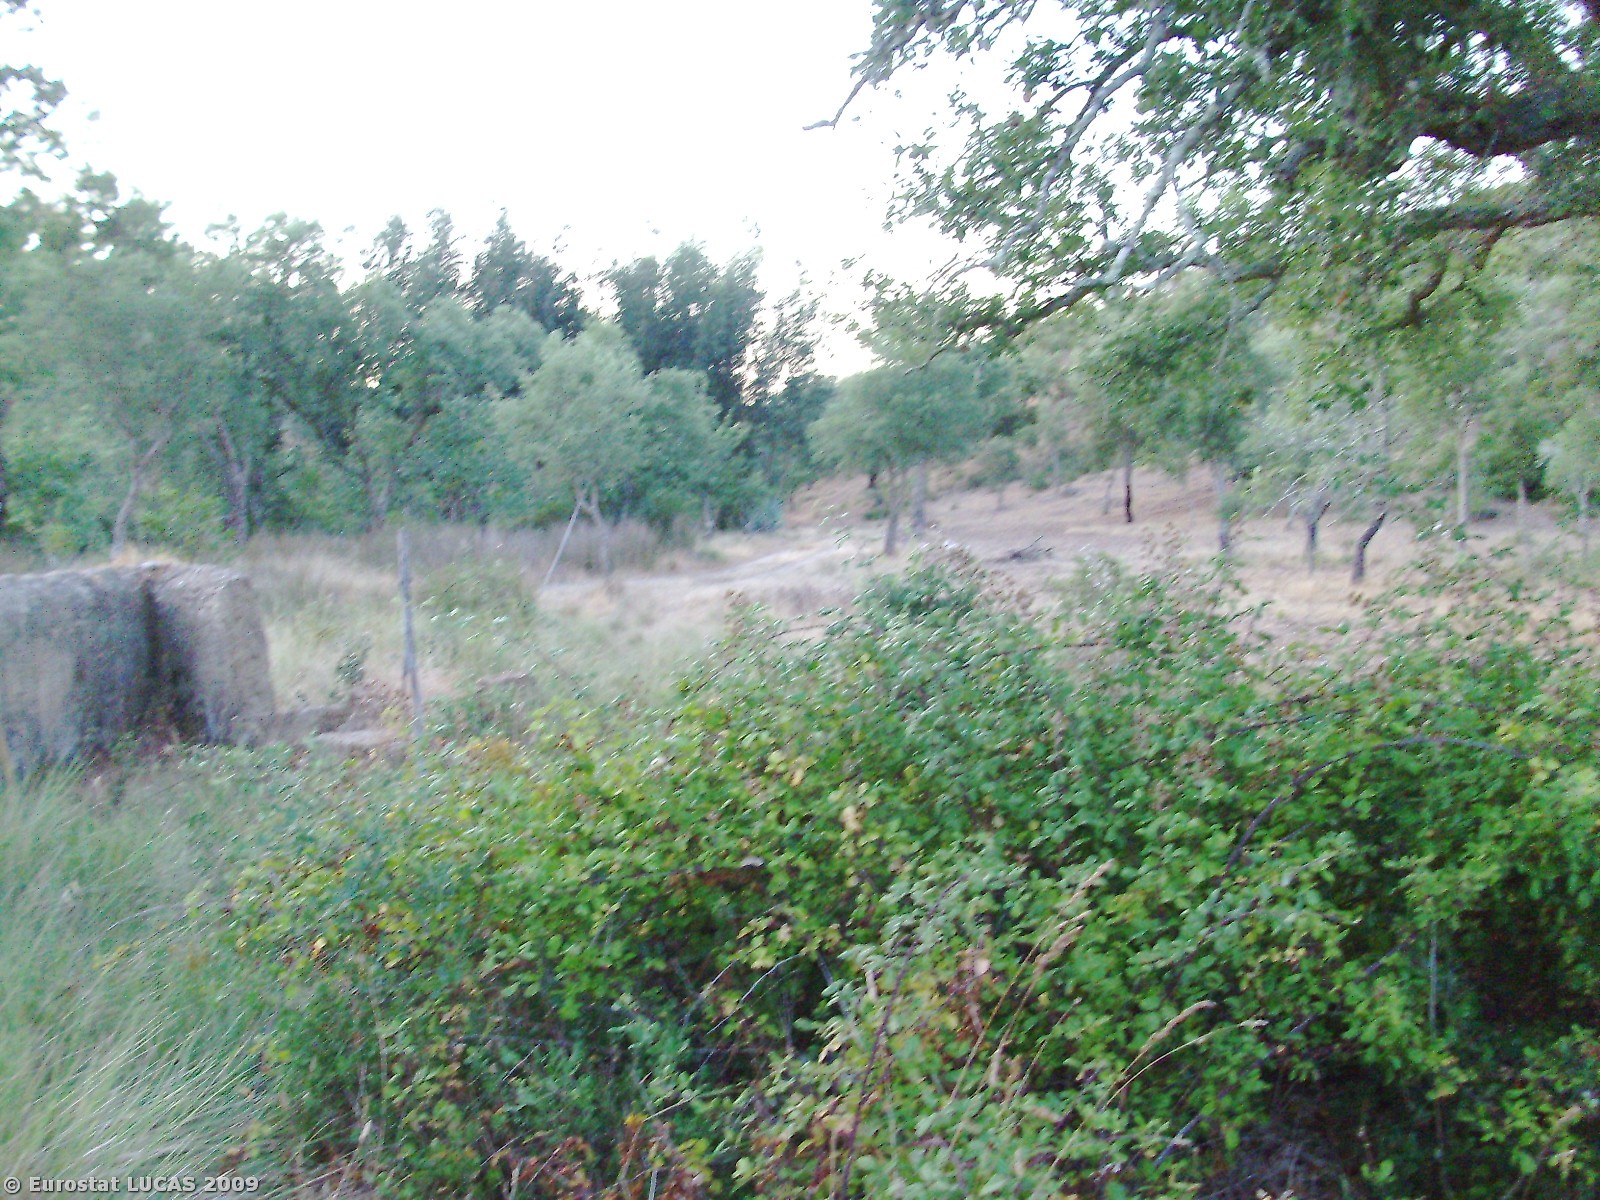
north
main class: Woodland
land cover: Broadleaved woodland
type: broadleaved evergreen forest
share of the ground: 10 - 25 %
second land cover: Grassland with sparse tree/shrub cover
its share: 50 - 75 %
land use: Forestry
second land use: Agriculture (excluding fallow land and kitchen gardens)
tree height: > 5 m
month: June
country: PT
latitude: 38.0959
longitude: -8.5297
